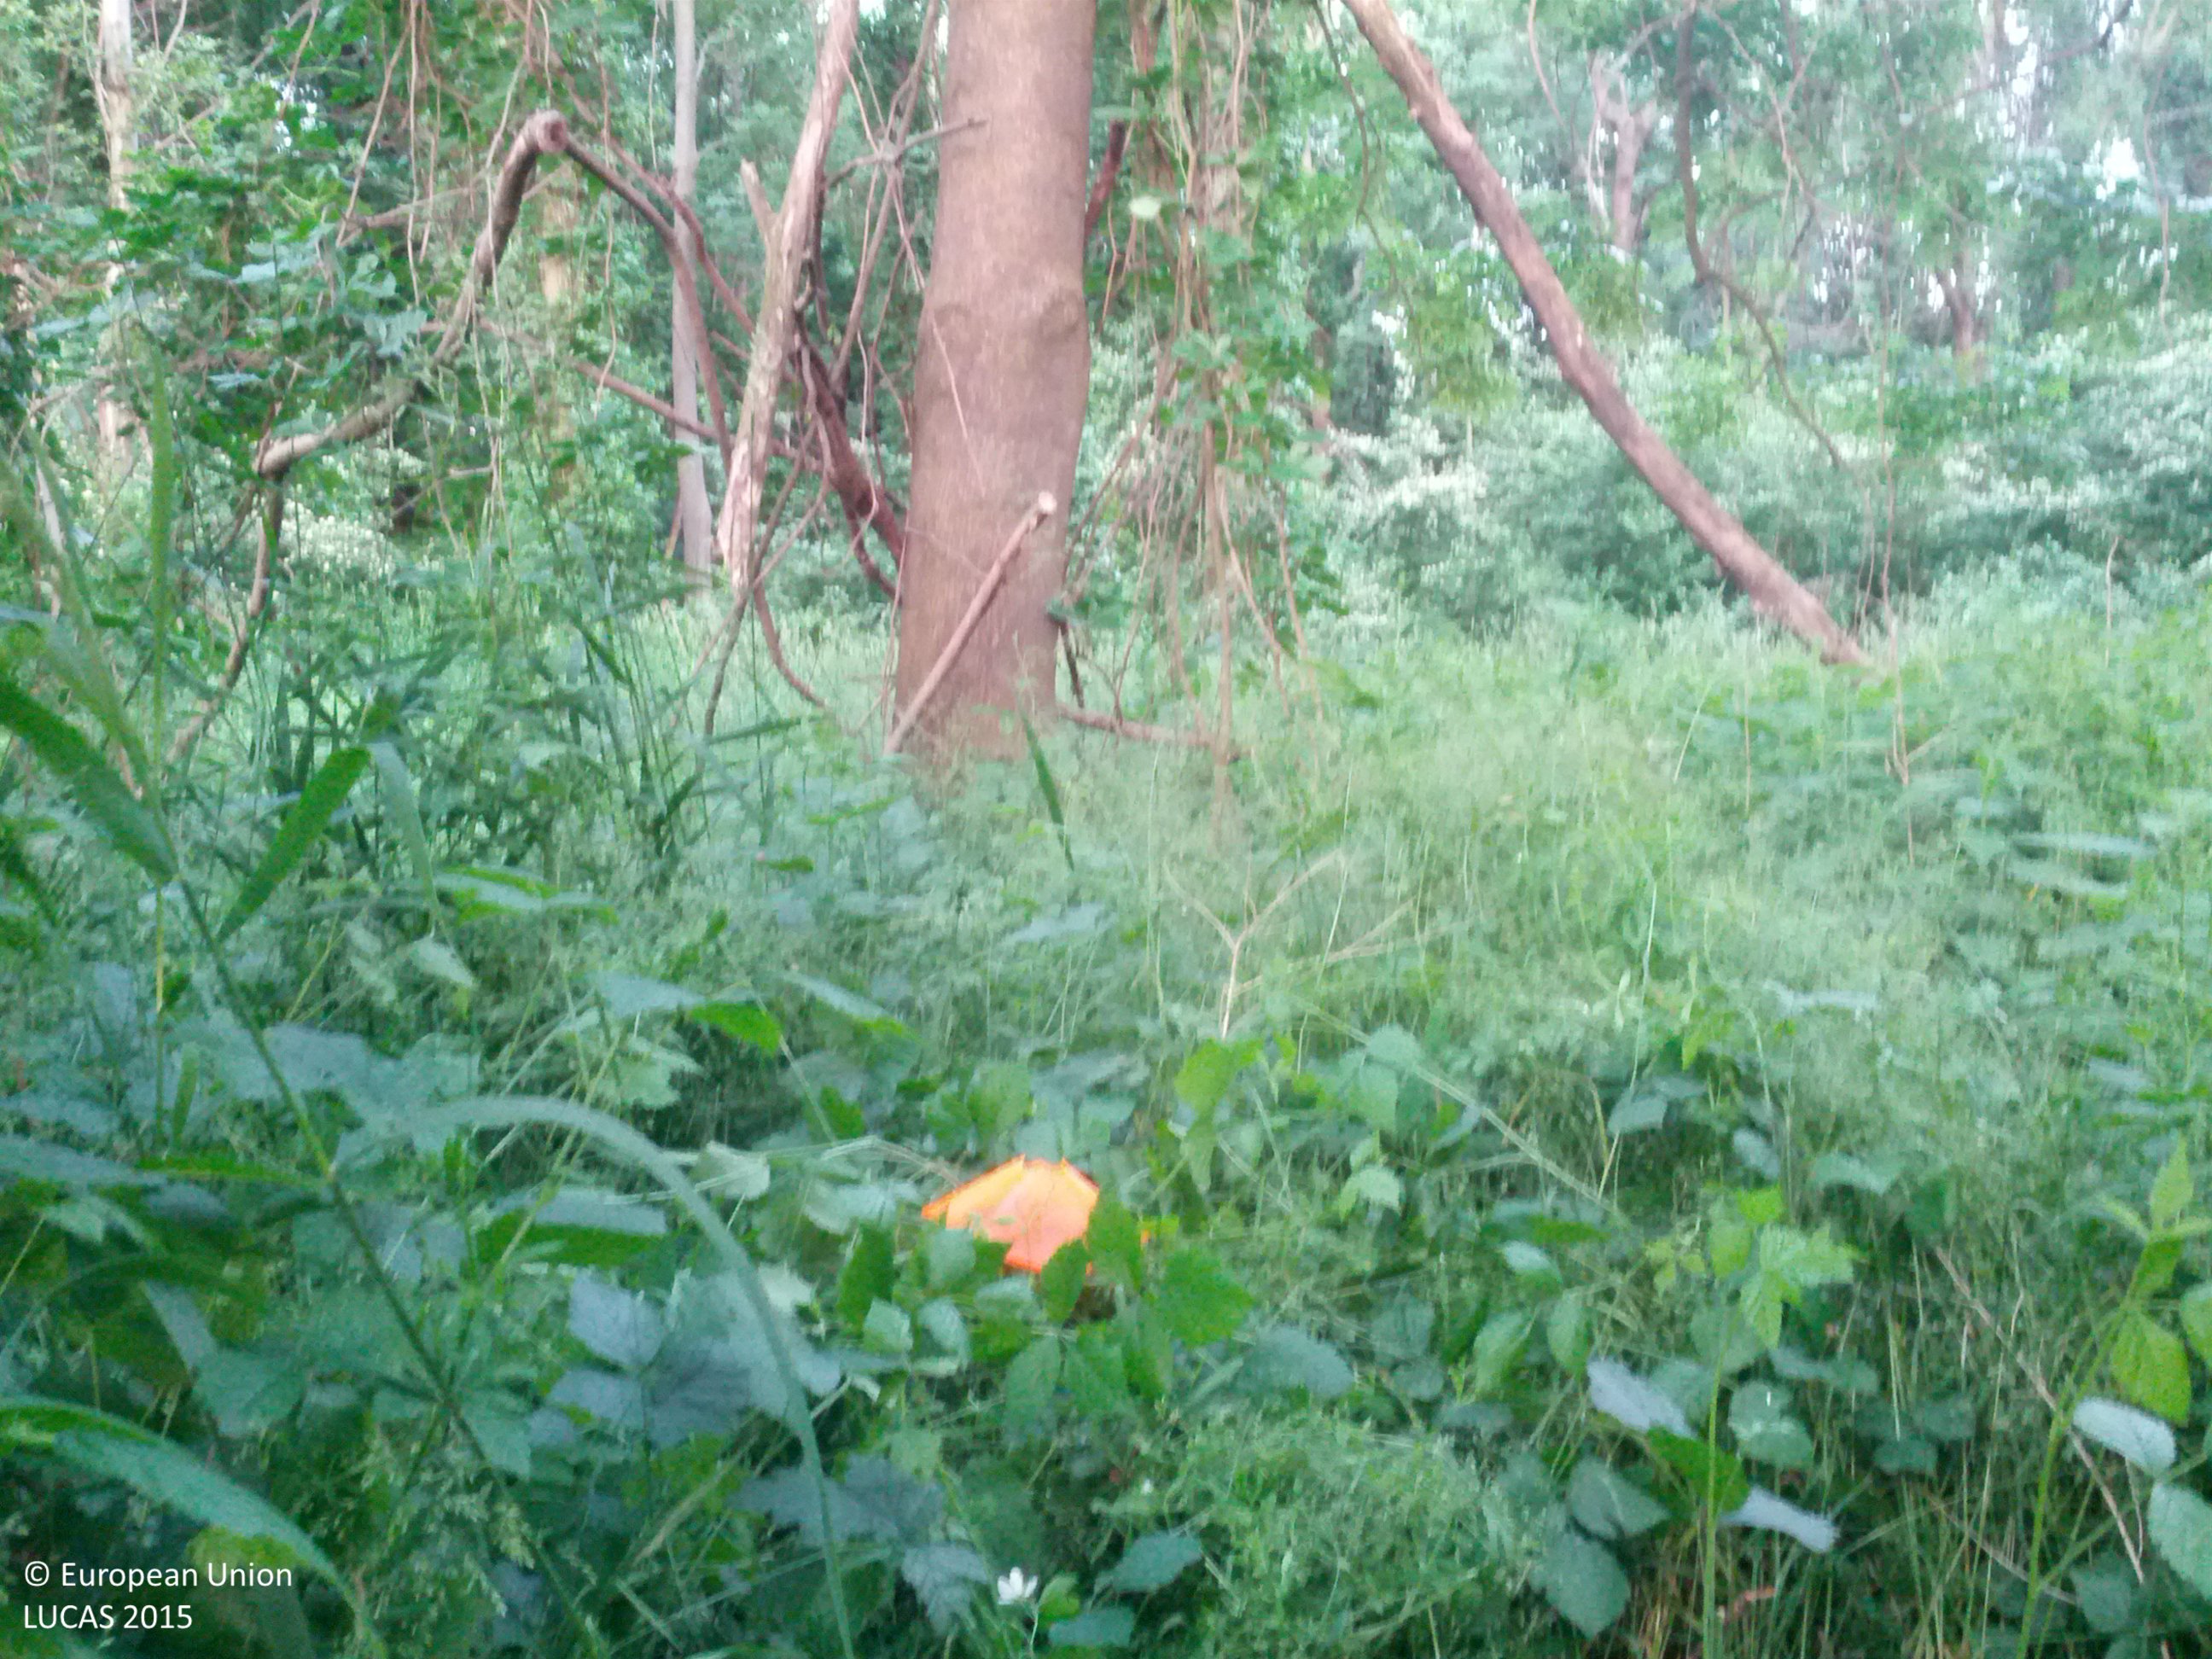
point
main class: Woodland
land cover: Broadleaved woodland
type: floodplain forest
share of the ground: 50 - 75 %
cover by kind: broadleaved forest trees 50 %, herbaceous plants 35 %, shrubs 15 %
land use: Forestry
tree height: > 5 m
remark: Temporary flooded
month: May
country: AT
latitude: 48.3319
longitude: 16.3044
